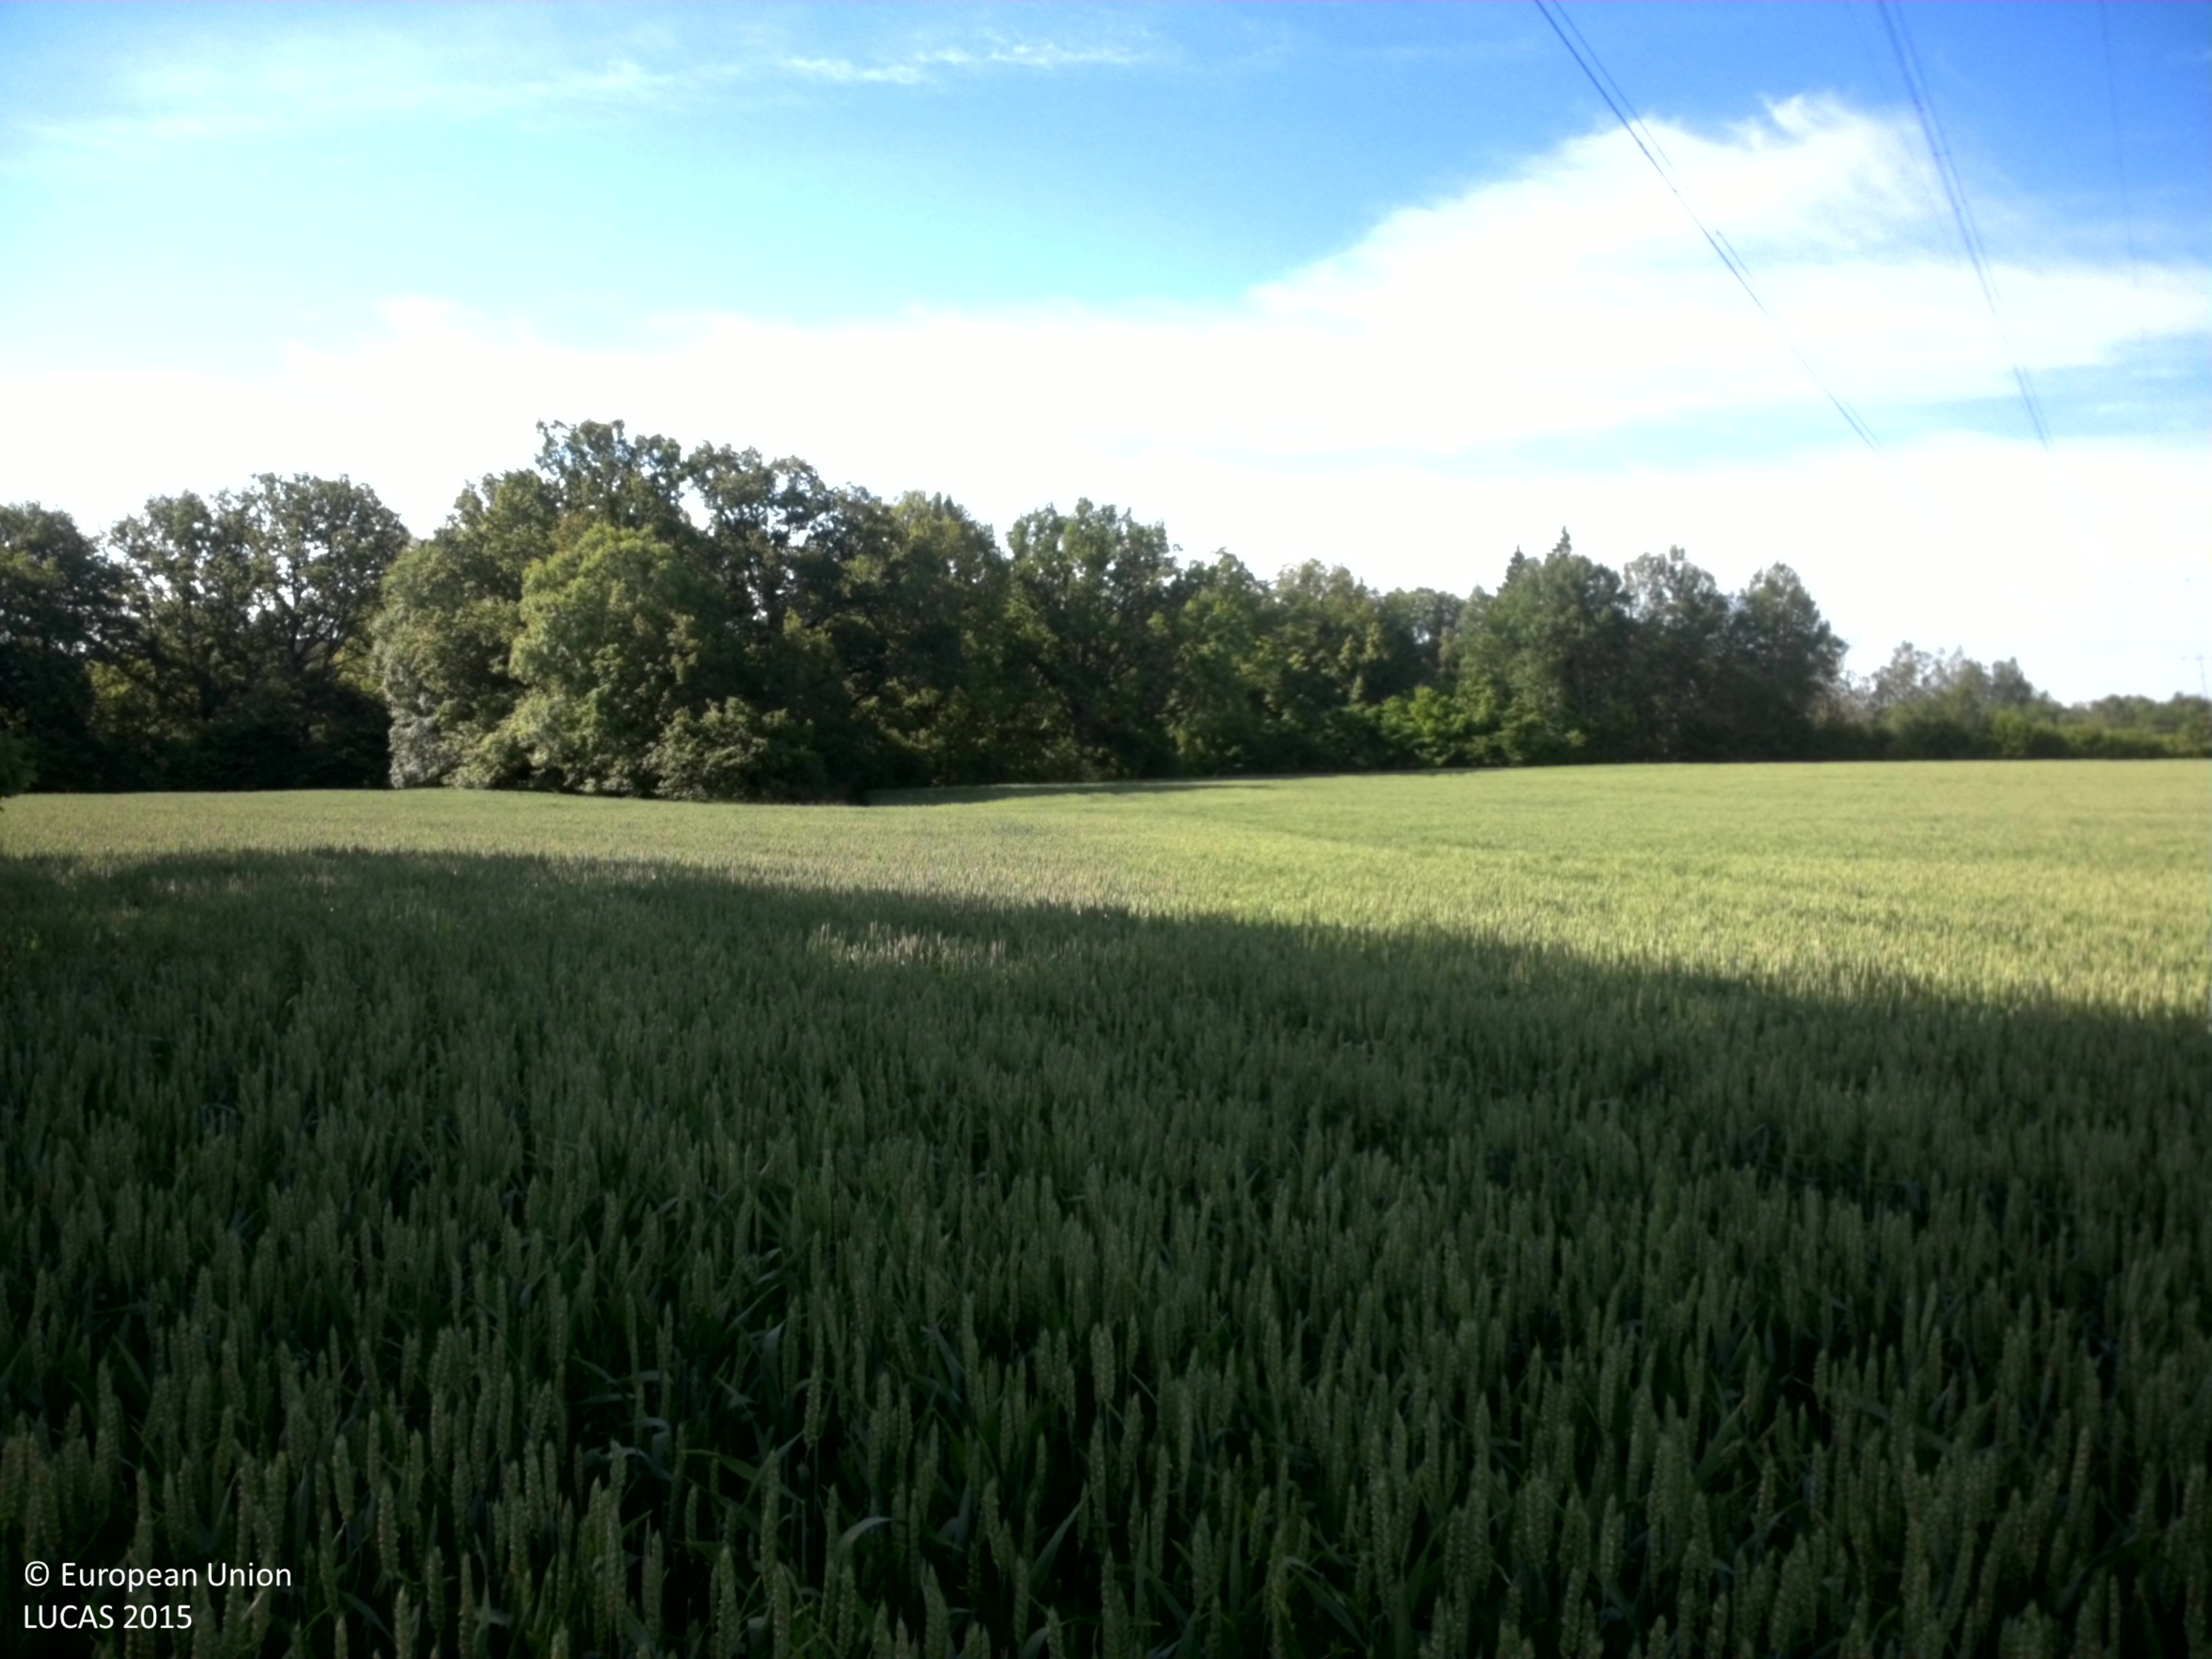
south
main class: Artificial land
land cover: Other artificial areas
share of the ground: > 75 %
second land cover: Common wheat
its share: > 75 %
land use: Electricity, gas and thermal power distribution
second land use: Agriculture (excluding fallow land and kitchen gardens)
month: June
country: SE
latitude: 58.5230
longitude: 15.4714
